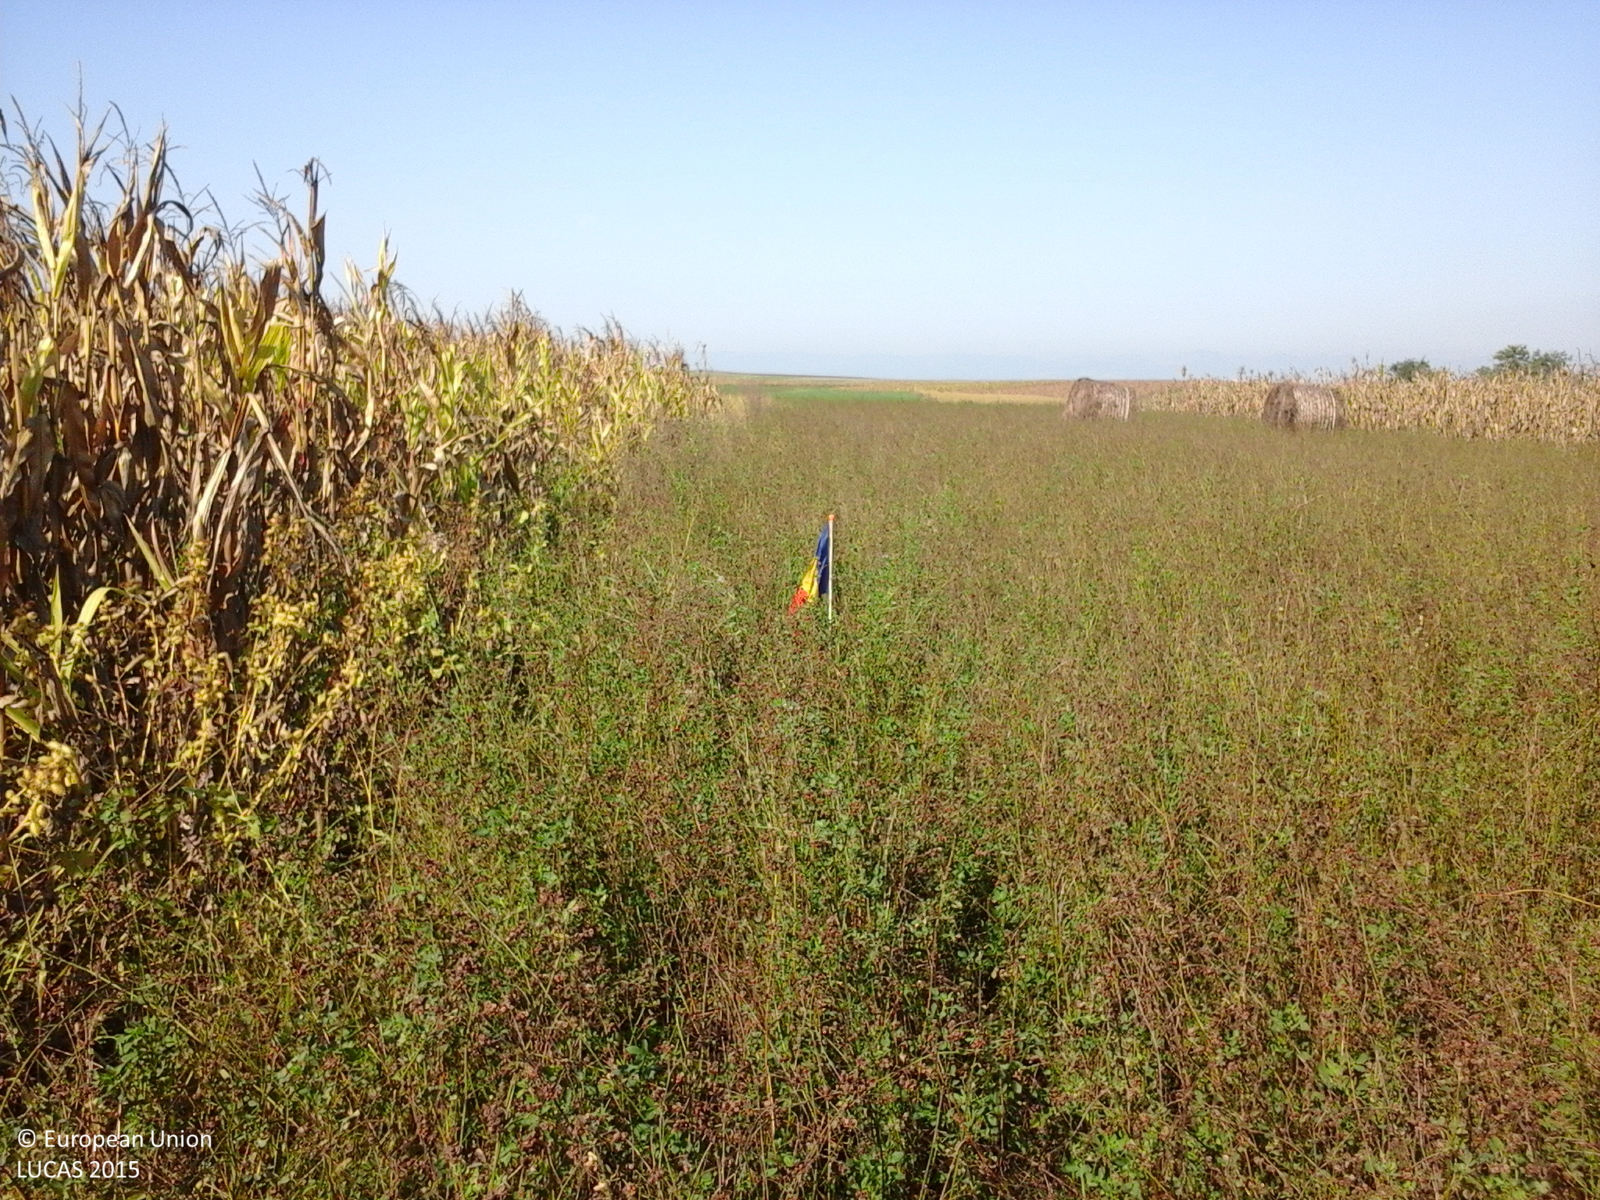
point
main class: Cropland
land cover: Lucerne
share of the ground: > 75 %
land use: Agriculture (excluding fallow land and kitchen gardens)
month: October
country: RO
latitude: 46.0673
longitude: 23.8394
